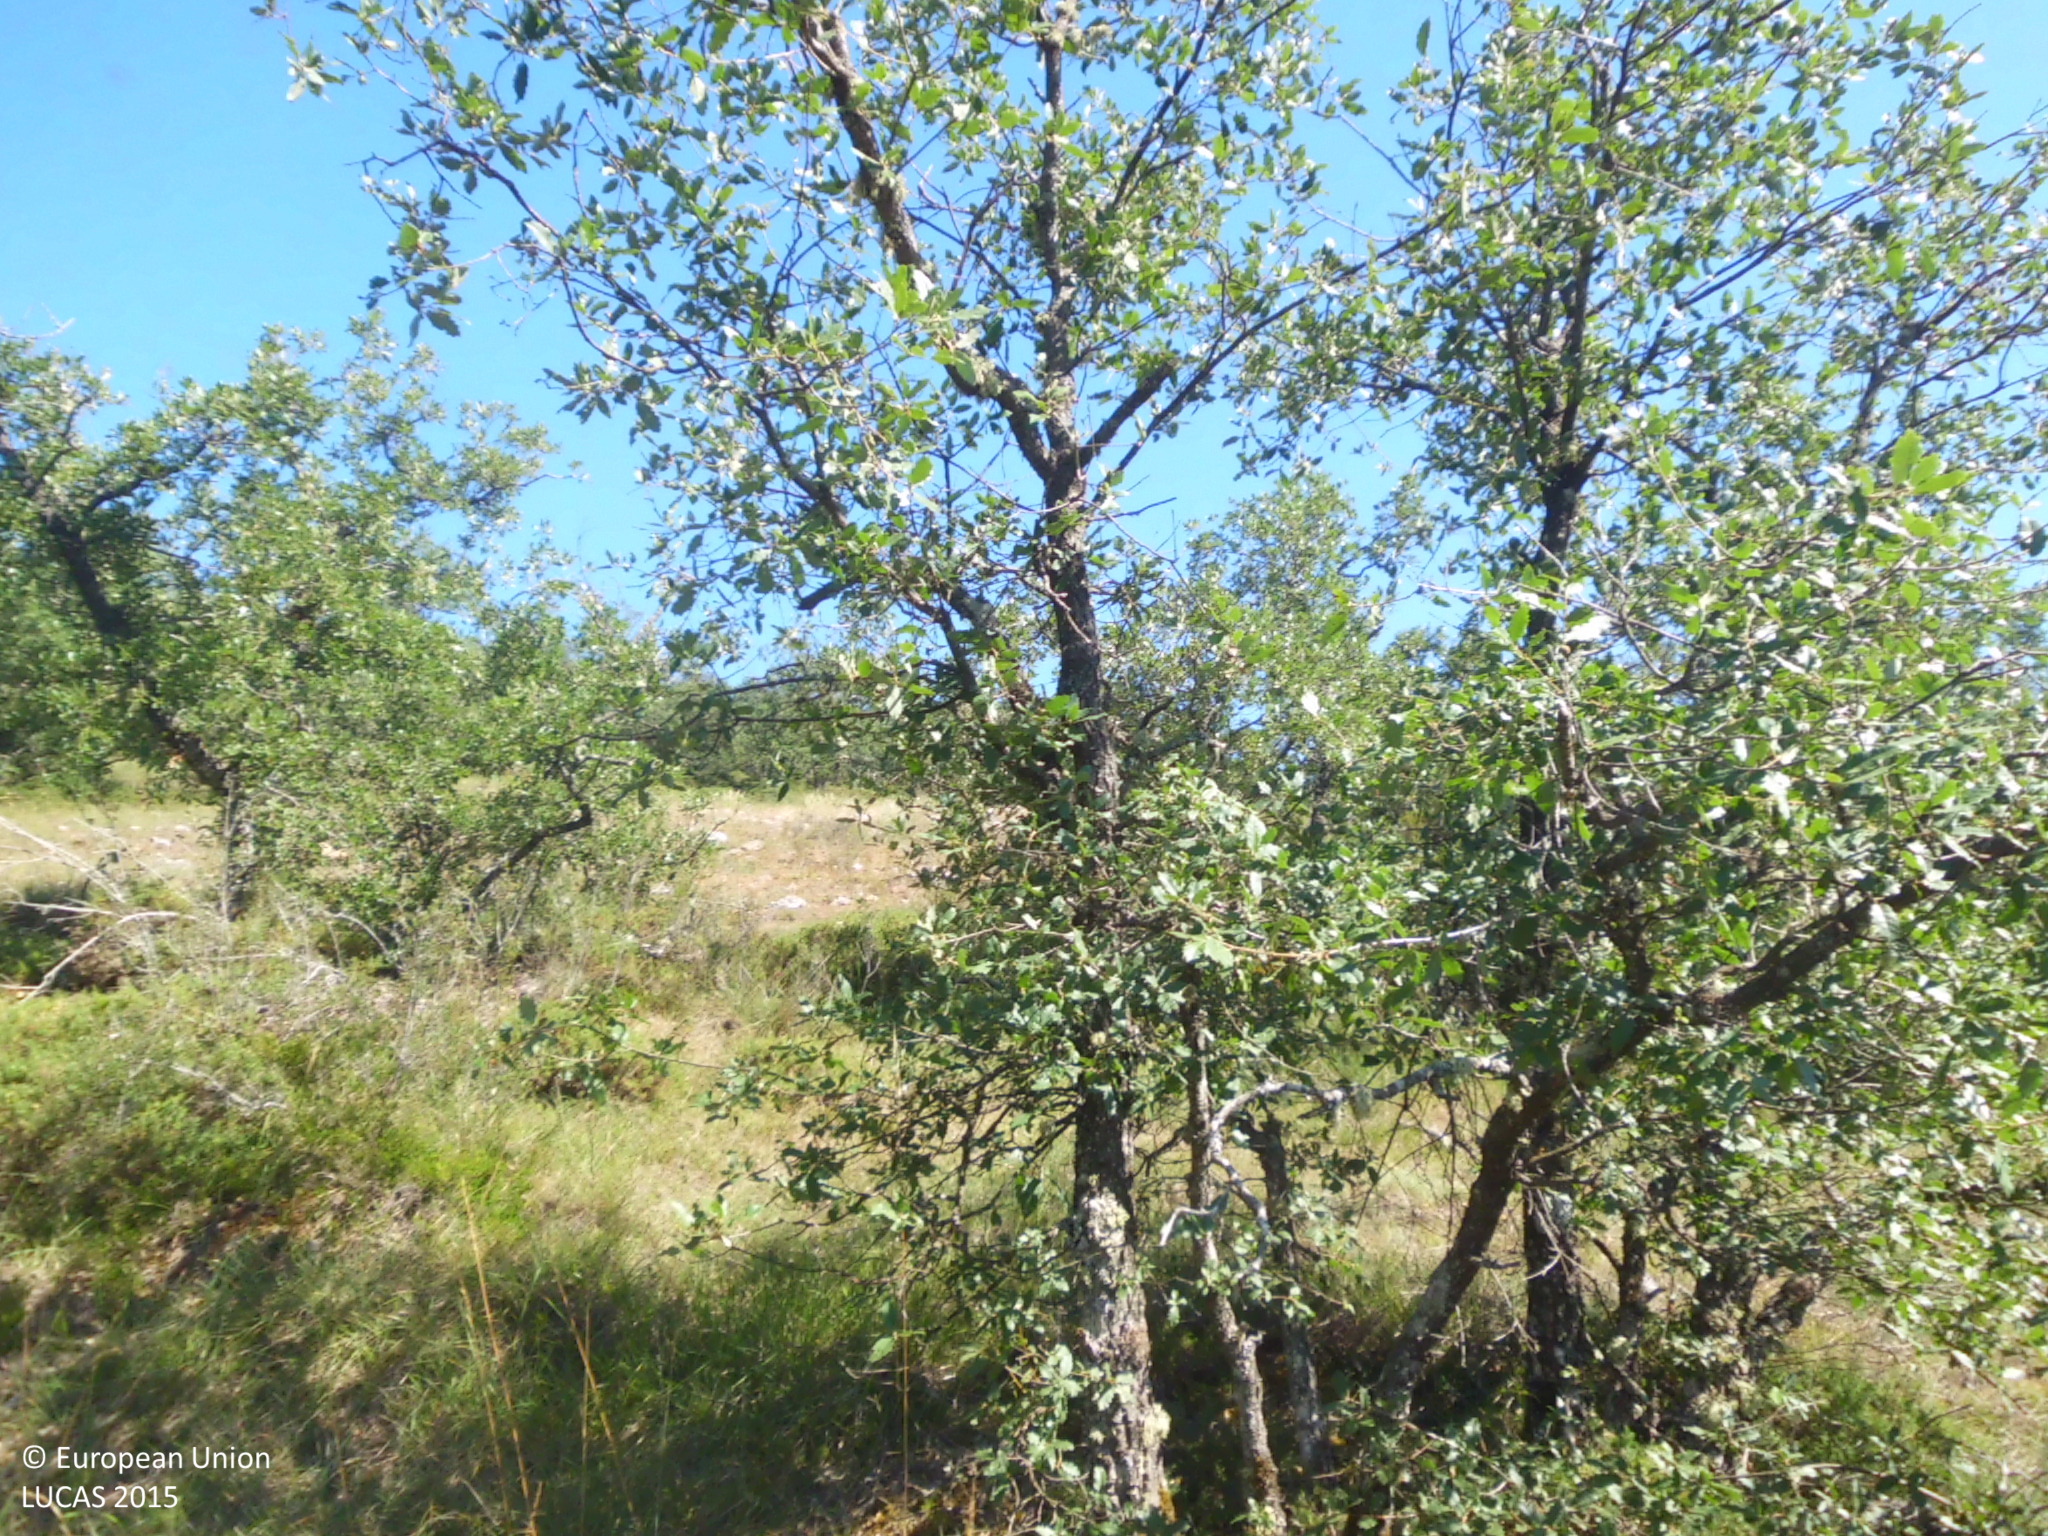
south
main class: Woodland
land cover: Broadleaved woodland
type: broadleaved evergreen forest
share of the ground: 25 - 50 %
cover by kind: broadleaved forest trees 40 %, herbaceous plants 30 %, consolidated bare surface 20 %, shrubs 10 %
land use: Semi-natural and natural areas not in use
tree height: > 5 m
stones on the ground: 10 - 25 %
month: July
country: ES
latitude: 42.7953
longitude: -4.3689
